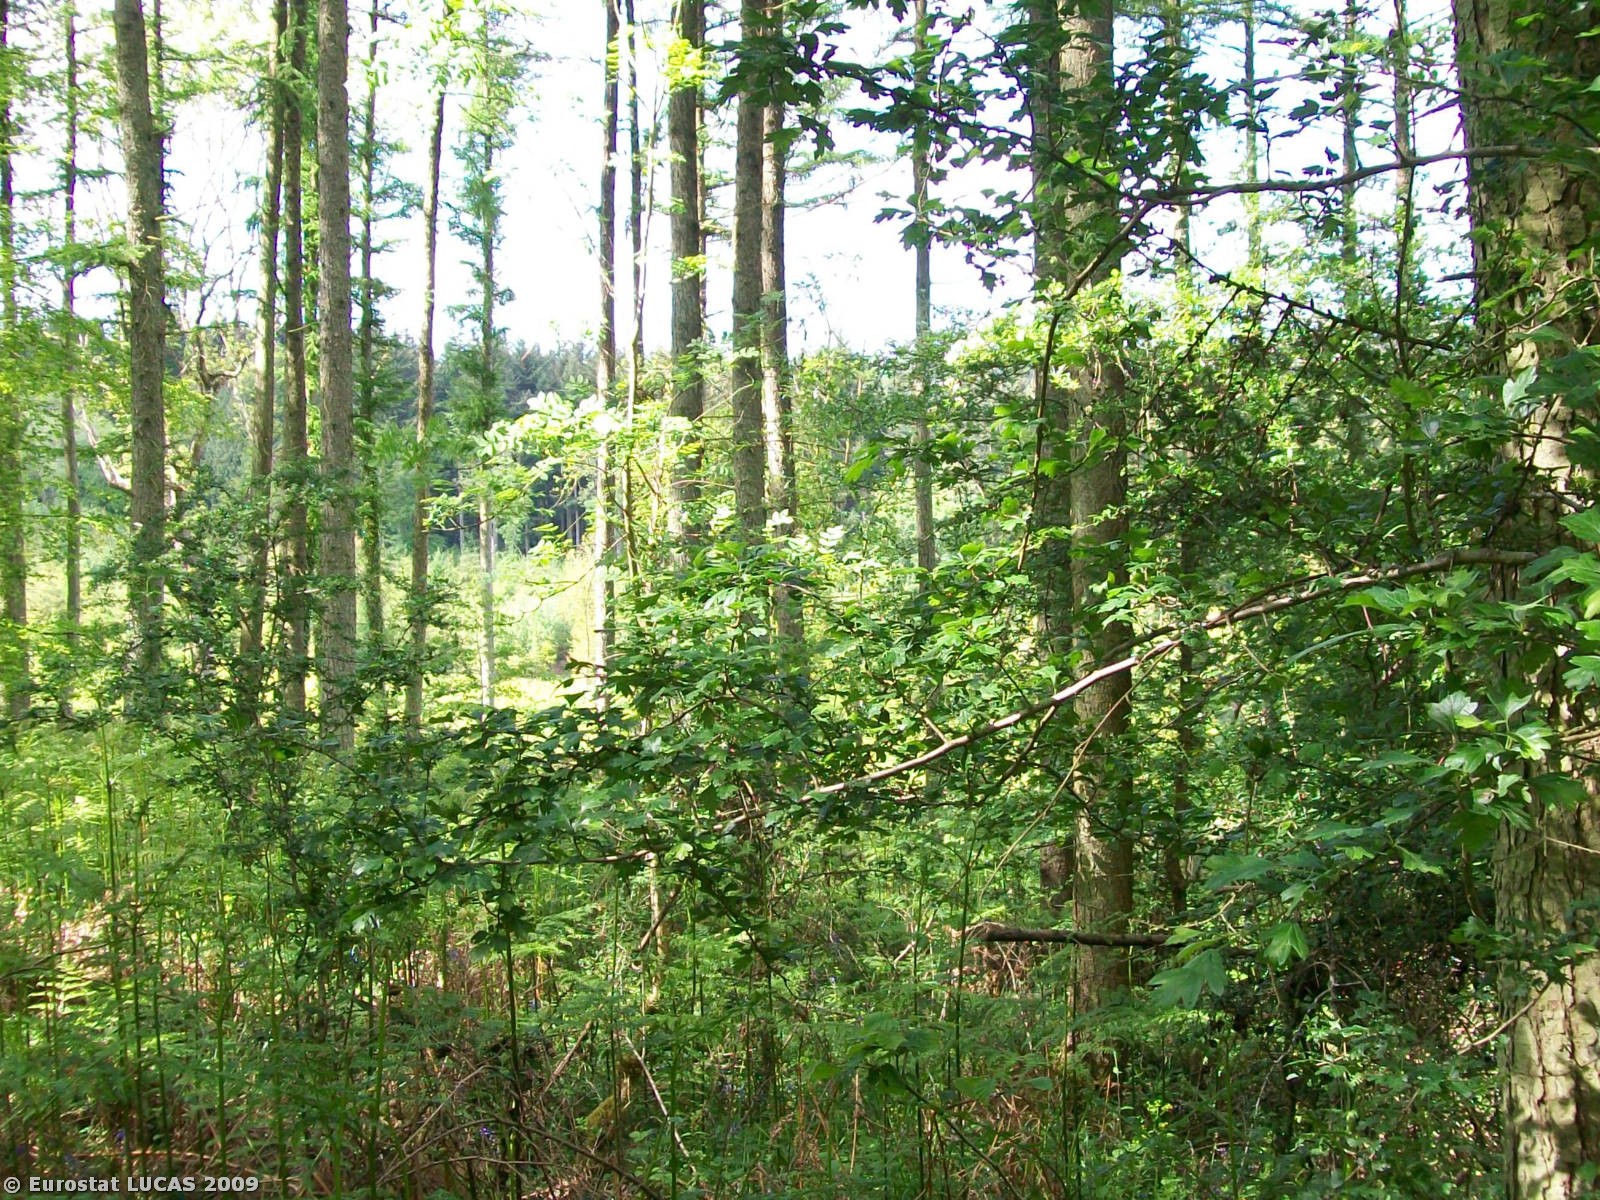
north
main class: Woodland
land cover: Mixed woodland
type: mesophytic deciduous forest
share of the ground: > 75 %
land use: Amenities, museums, leisure
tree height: > 5 m
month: May
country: GB
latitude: 50.9330
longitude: -2.1410
